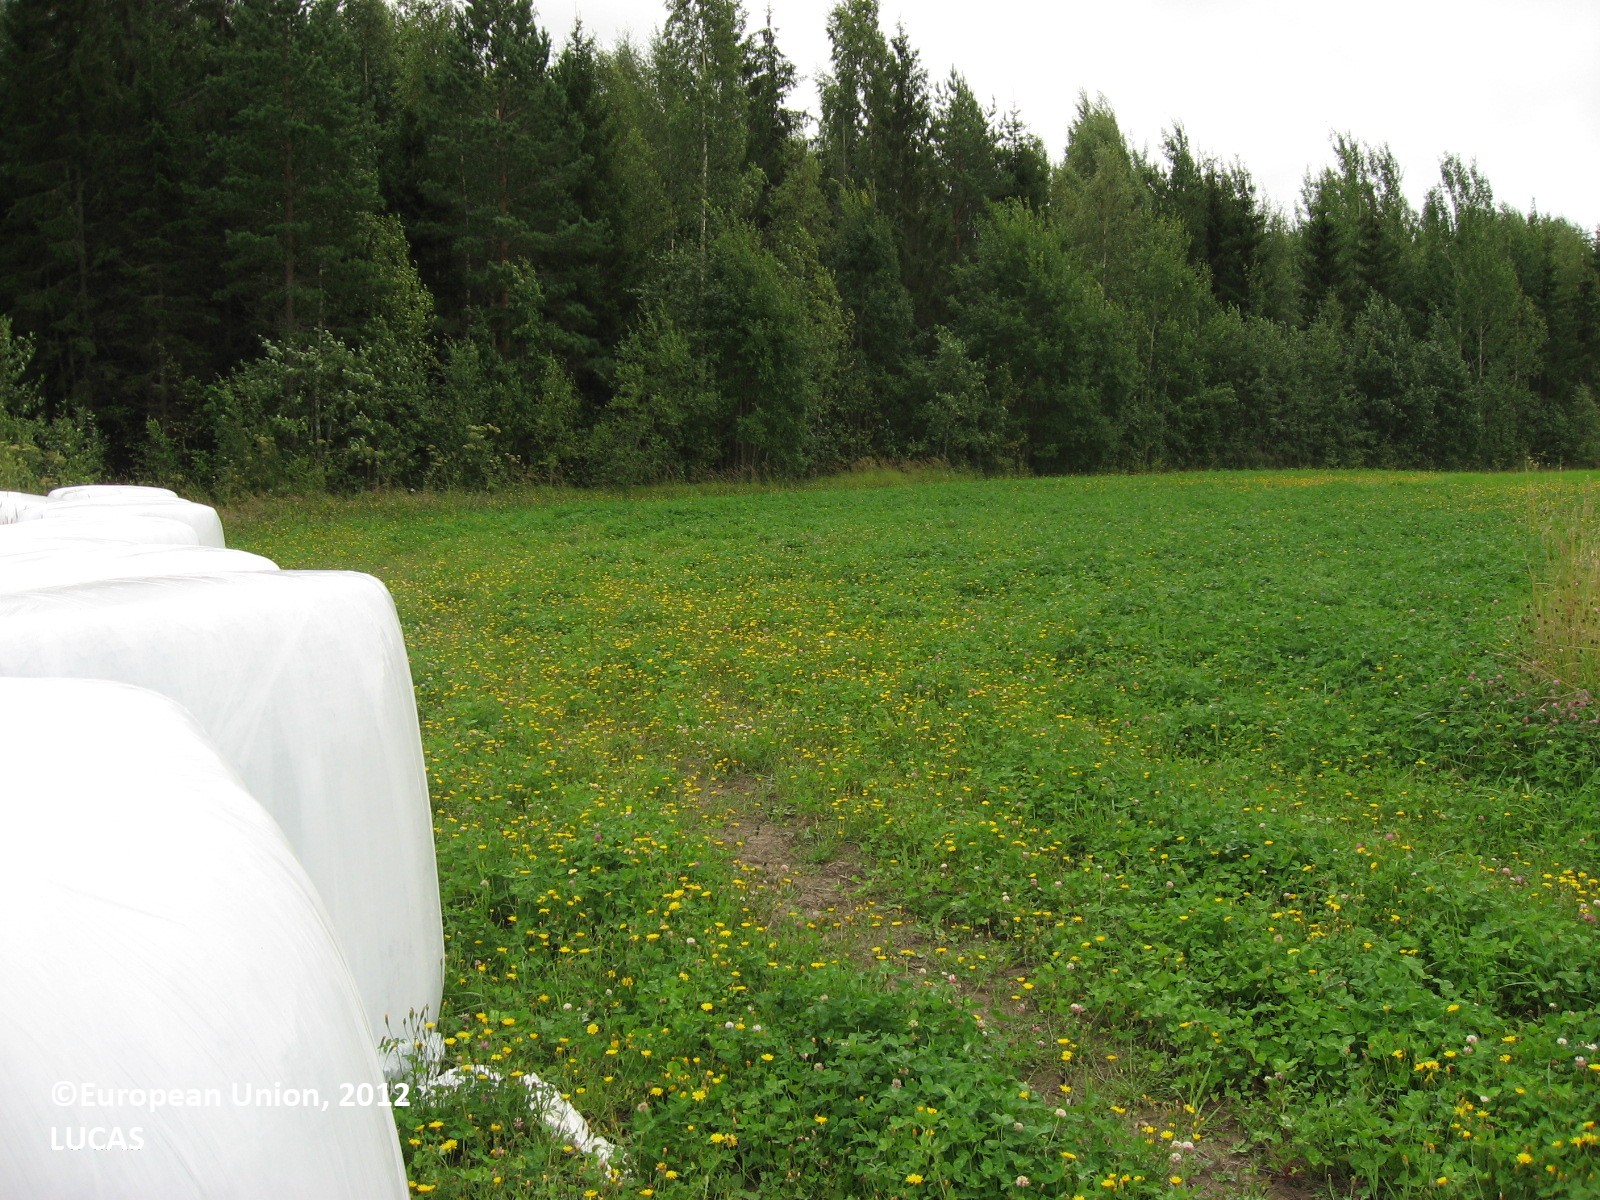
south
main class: Cropland
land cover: Clovers
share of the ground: > 75 %
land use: Agriculture (excluding fallow land and kitchen gardens)
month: August
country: FI
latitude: 60.6891
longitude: 25.5667
